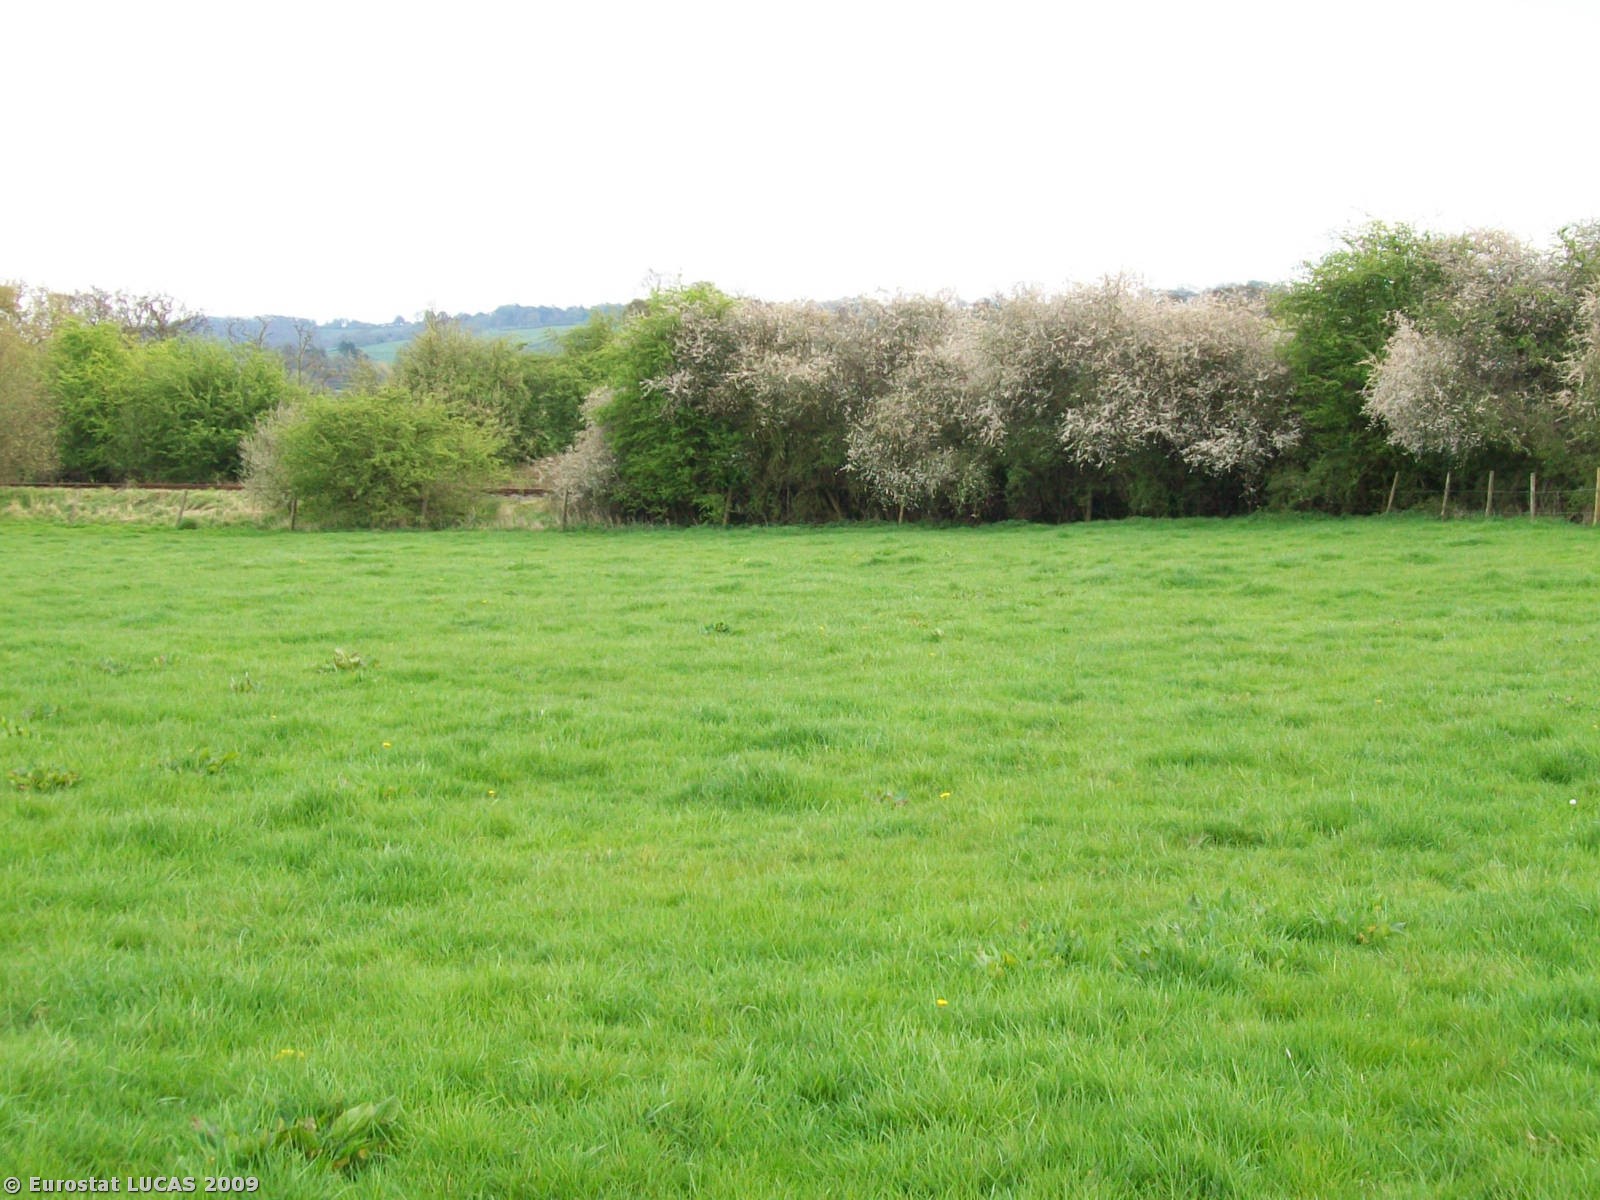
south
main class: Grassland
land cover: Grassland with sparse tree/shrub cover
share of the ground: > 75 %
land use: Agriculture (excluding fallow land and kitchen gardens)
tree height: > 5 m
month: April
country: GB
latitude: 52.9965
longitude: -1.5083
